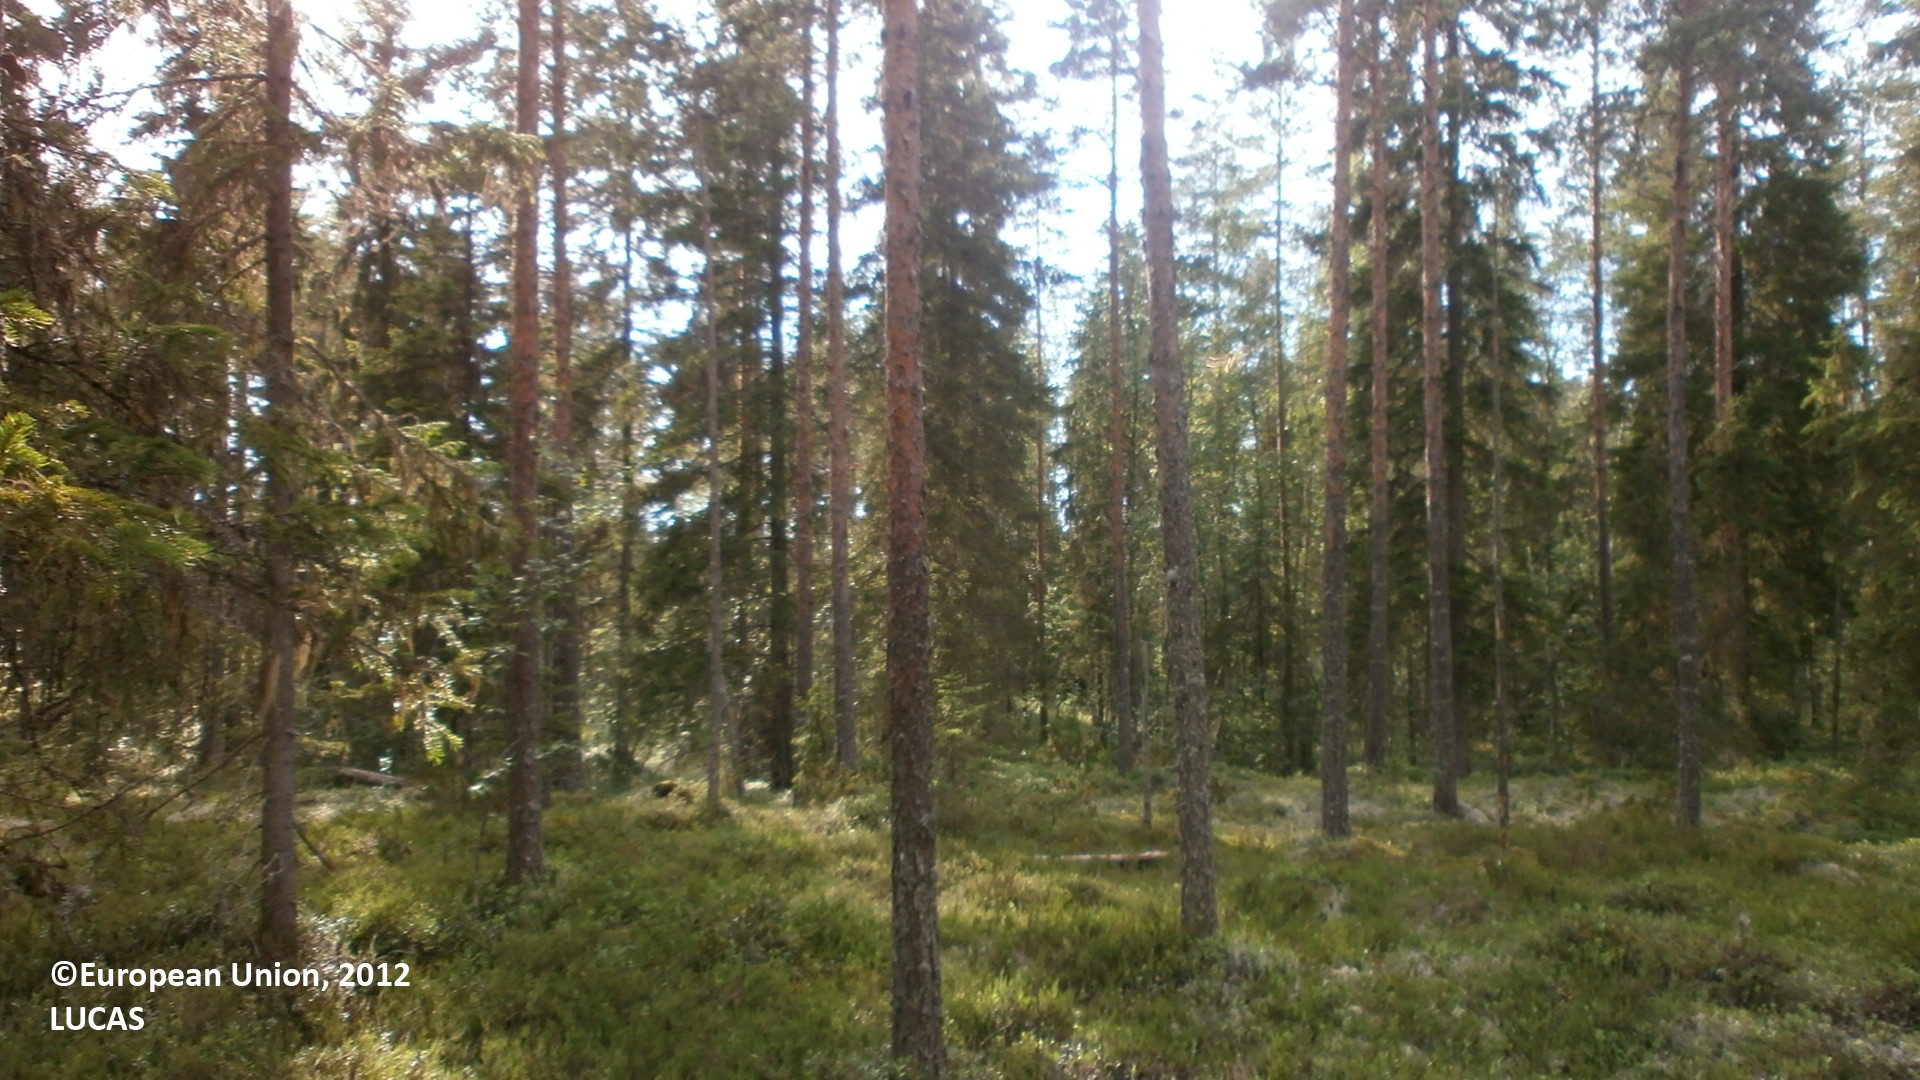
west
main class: Woodland
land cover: Pine dominated coniferous woodland
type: boreal forest
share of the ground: 50 - 75 %
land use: Forestry
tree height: > 5 m
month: July
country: FI
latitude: 64.3611
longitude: 24.4236
